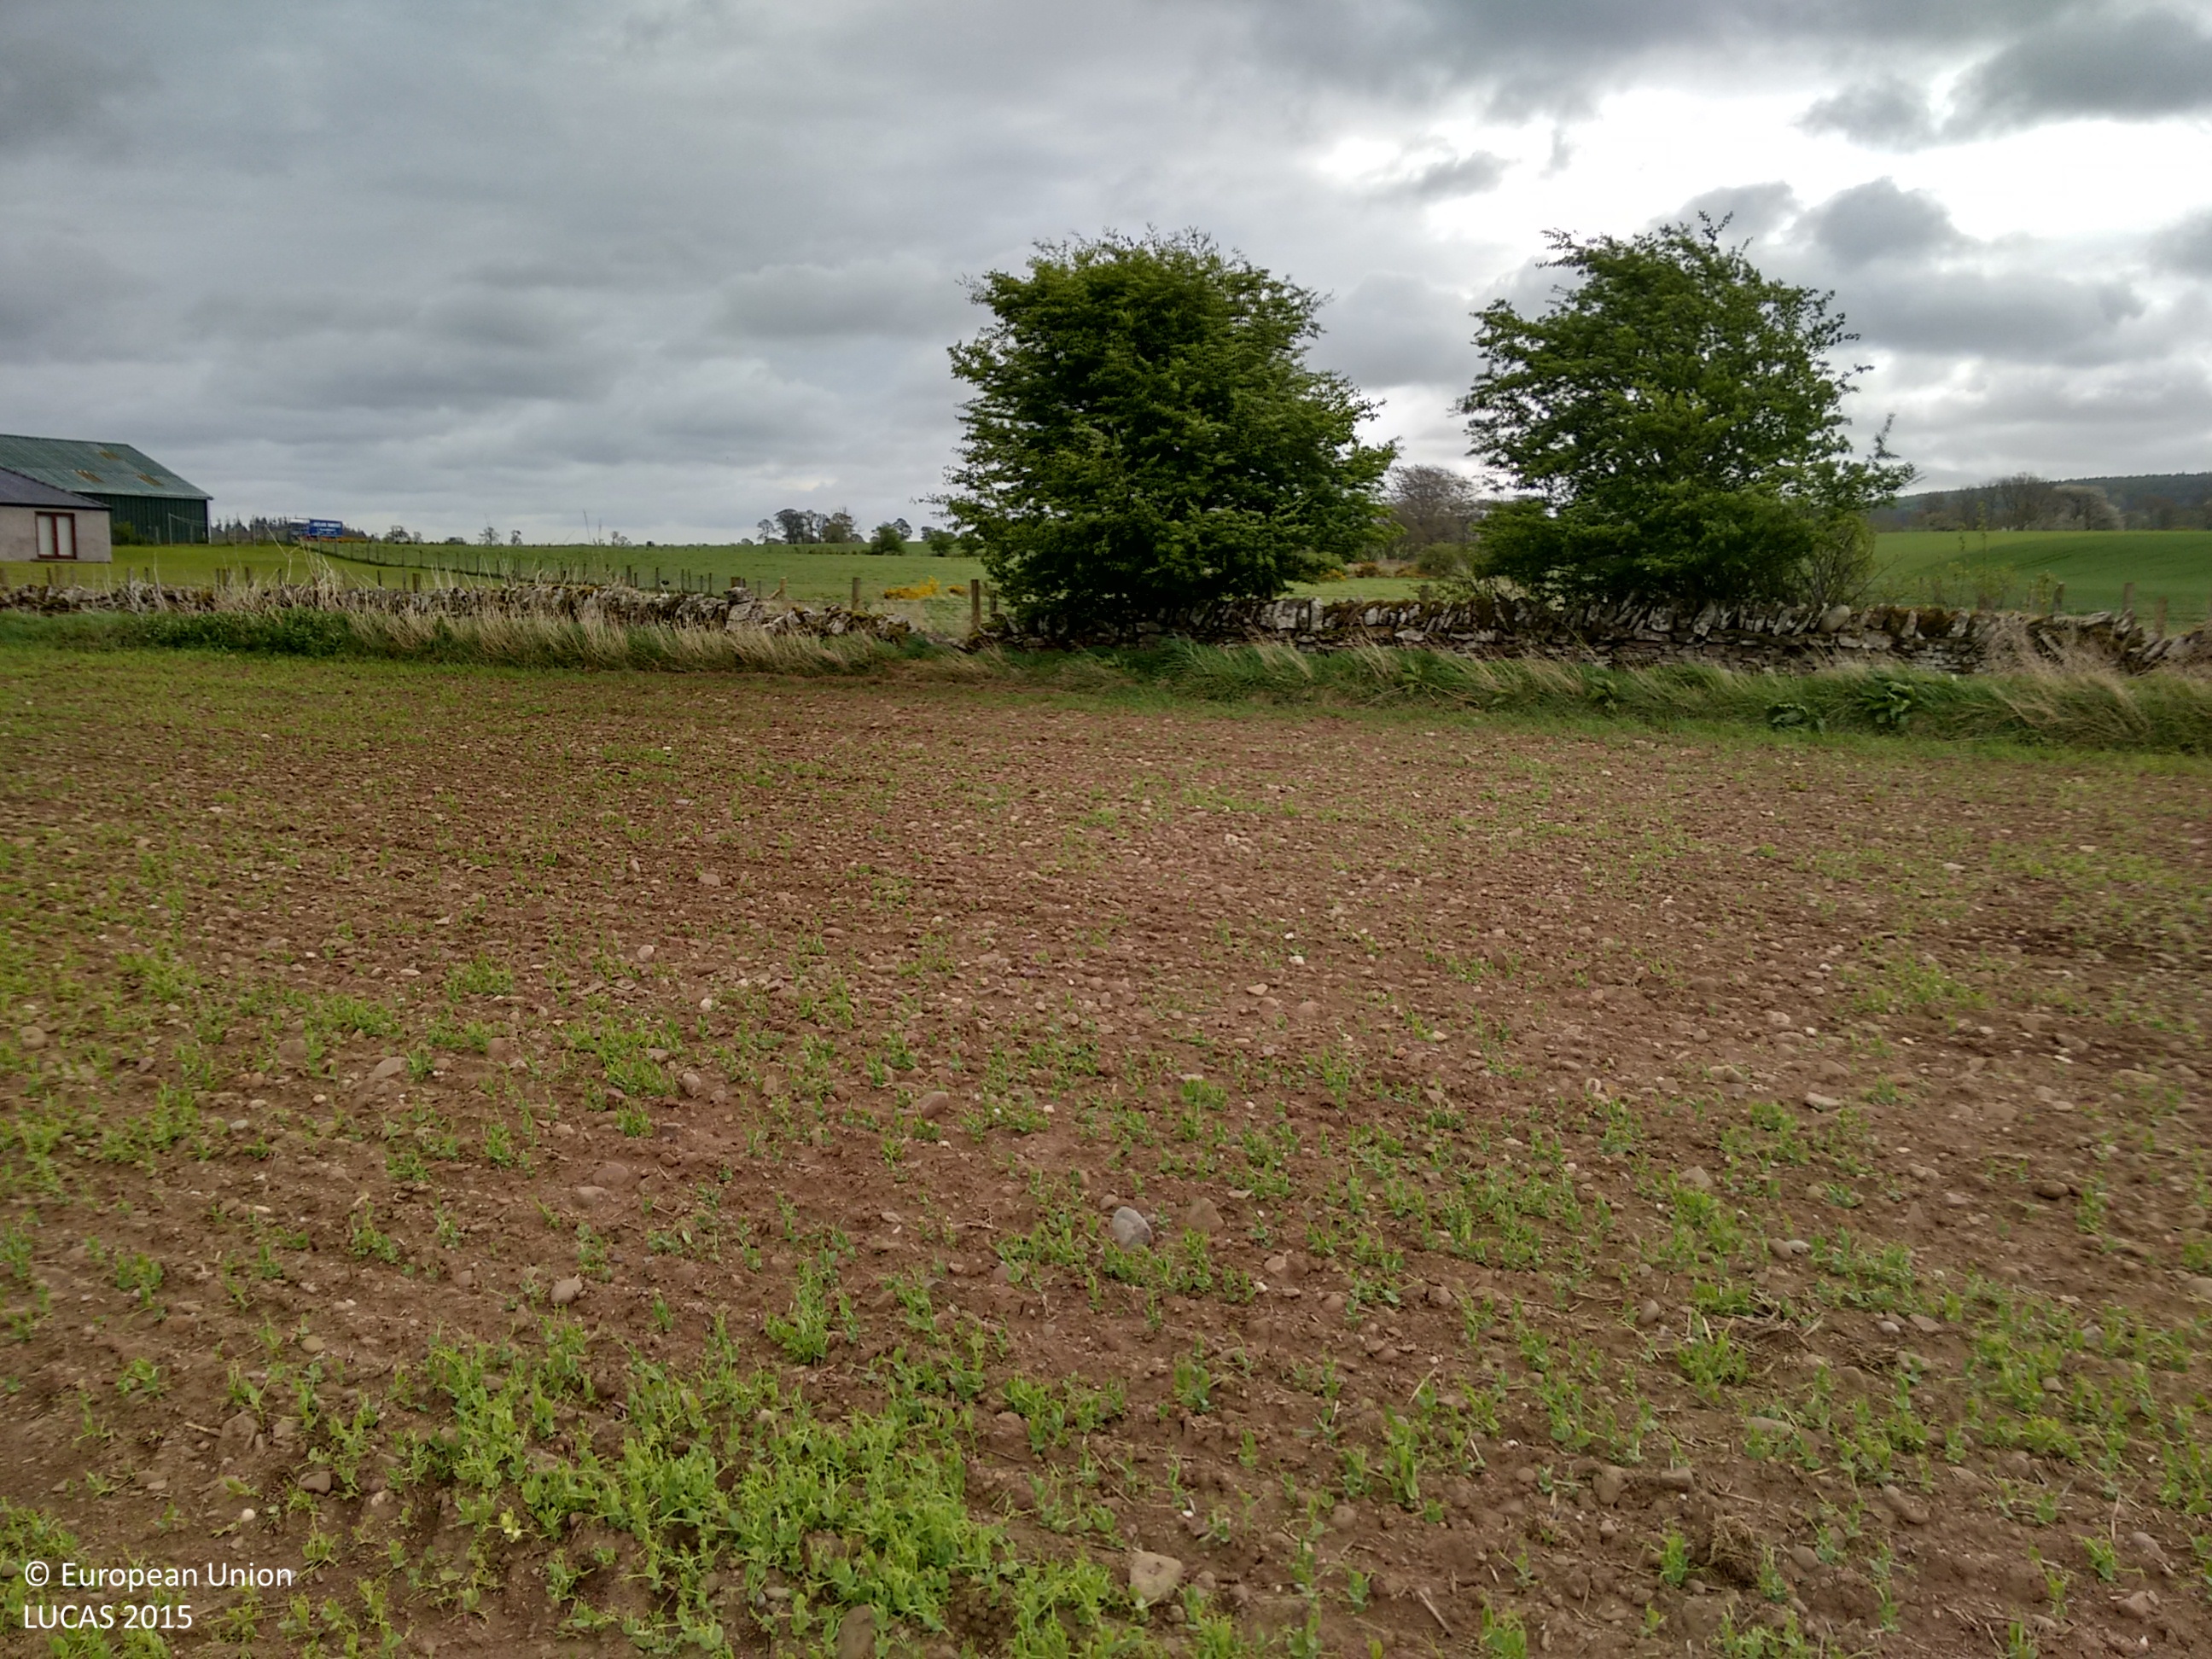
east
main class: Cropland
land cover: Dry pulses
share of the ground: 25 - 50 %
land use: Agriculture (excluding fallow land and kitchen gardens)
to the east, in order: Dry pulses; Grass margins; Dry stone walls; Single bushes/trees; Fences; Single bushes/trees; Grassland without tree/shrub cover; Inland fresh running water; Grassland without tree/shrub cover
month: May
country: GB
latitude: 56.6120
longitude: -3.0521
